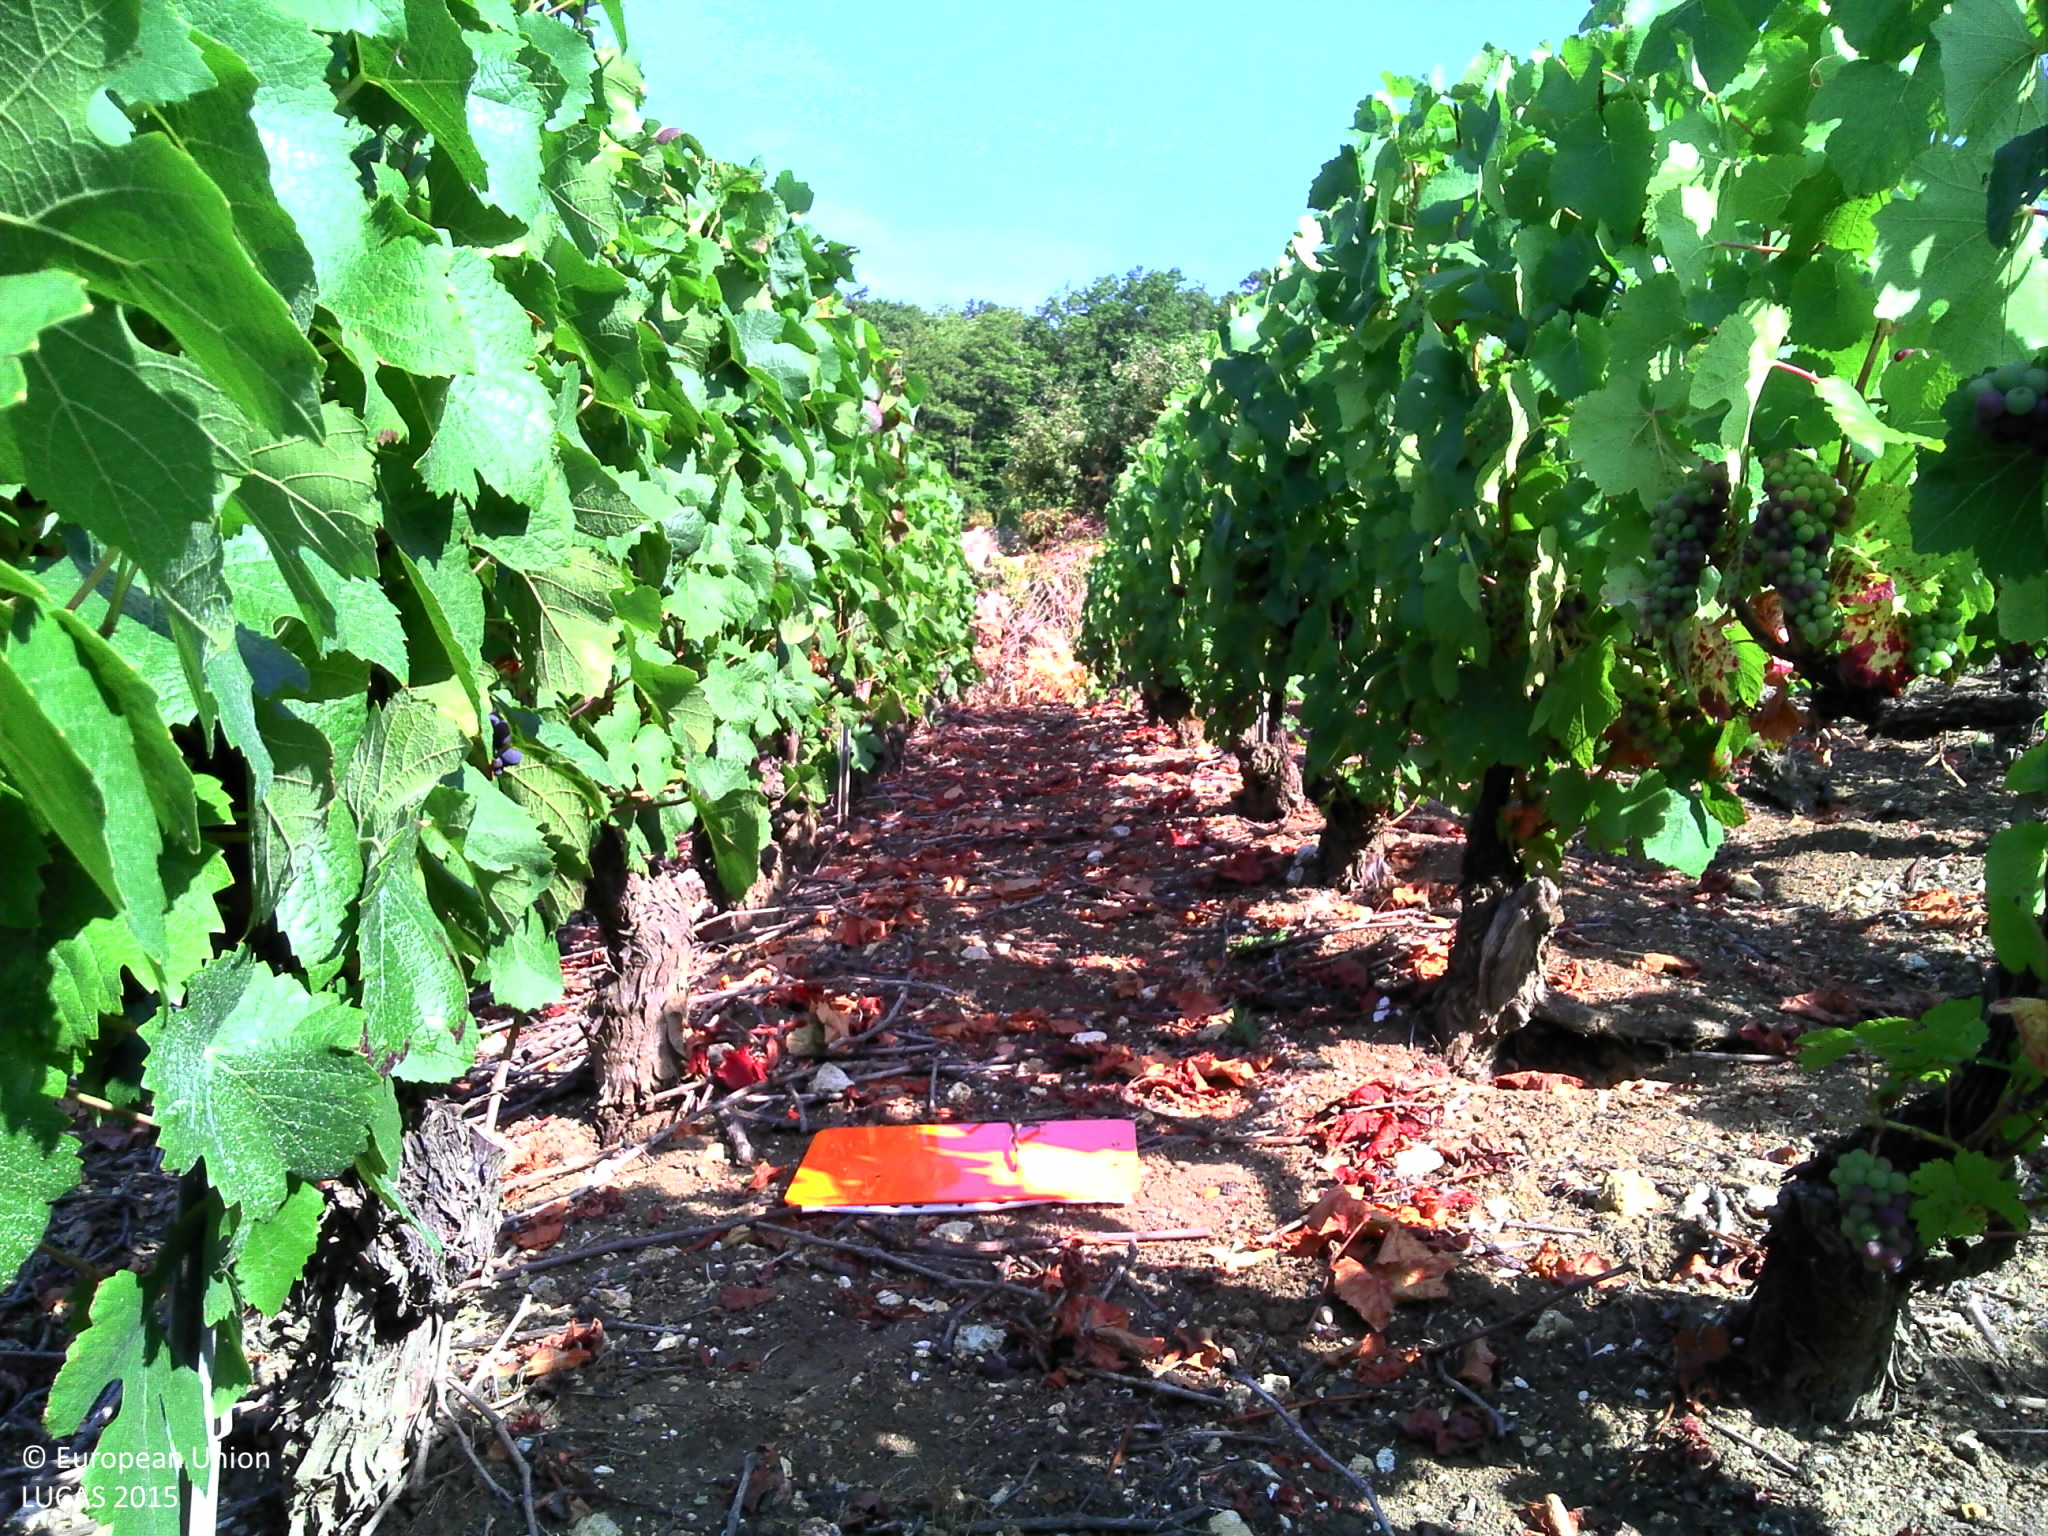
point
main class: Cropland
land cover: Vineyards
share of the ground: > 75 %
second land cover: Other bare soil
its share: > 75 %
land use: Agriculture (excluding fallow land and kitchen gardens)
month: August
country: FR
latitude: 49.0562
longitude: 3.7404
